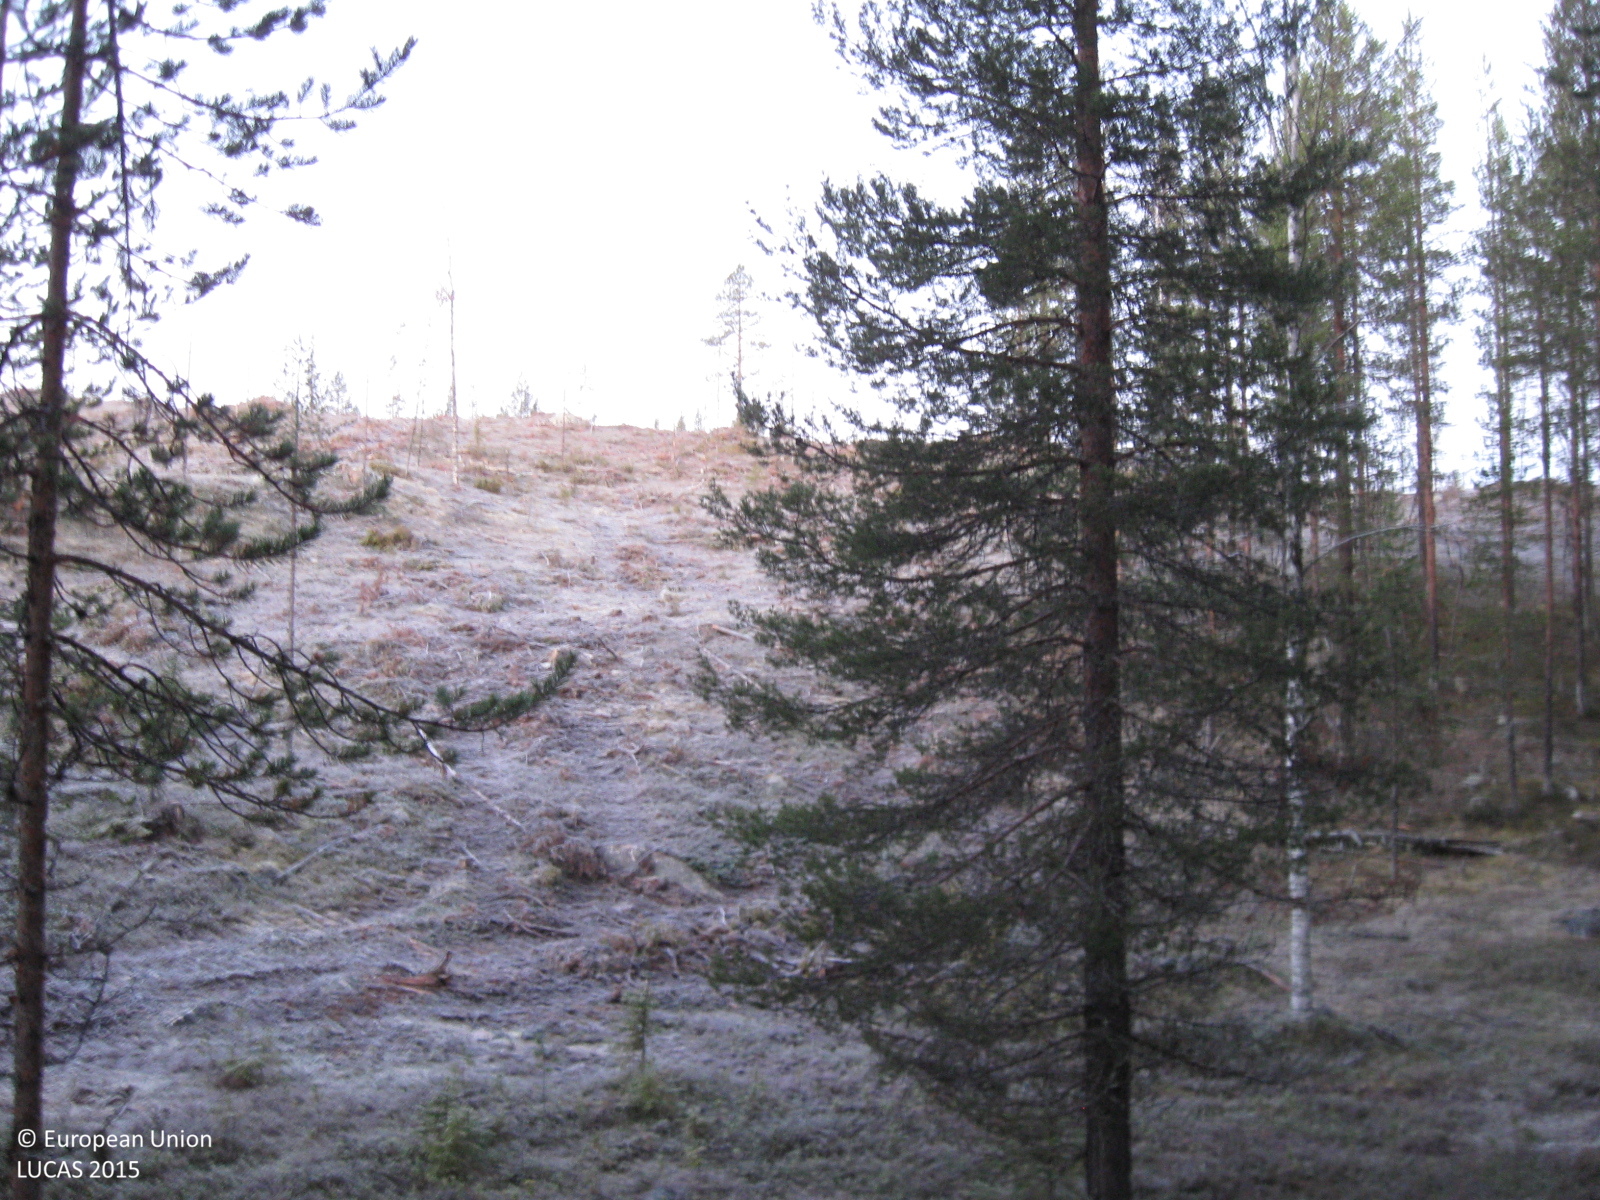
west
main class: Woodland
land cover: Pine dominated coniferous woodland
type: boreal forest
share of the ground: 50 - 75 %
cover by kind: coniferous forest trees 70 %, shrubs 20 %, herbaceous plants 5 %, lichens and mosses 5 %
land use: Forestry
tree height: > 5 m
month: October
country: SE
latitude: 66.4847
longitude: 20.9871
